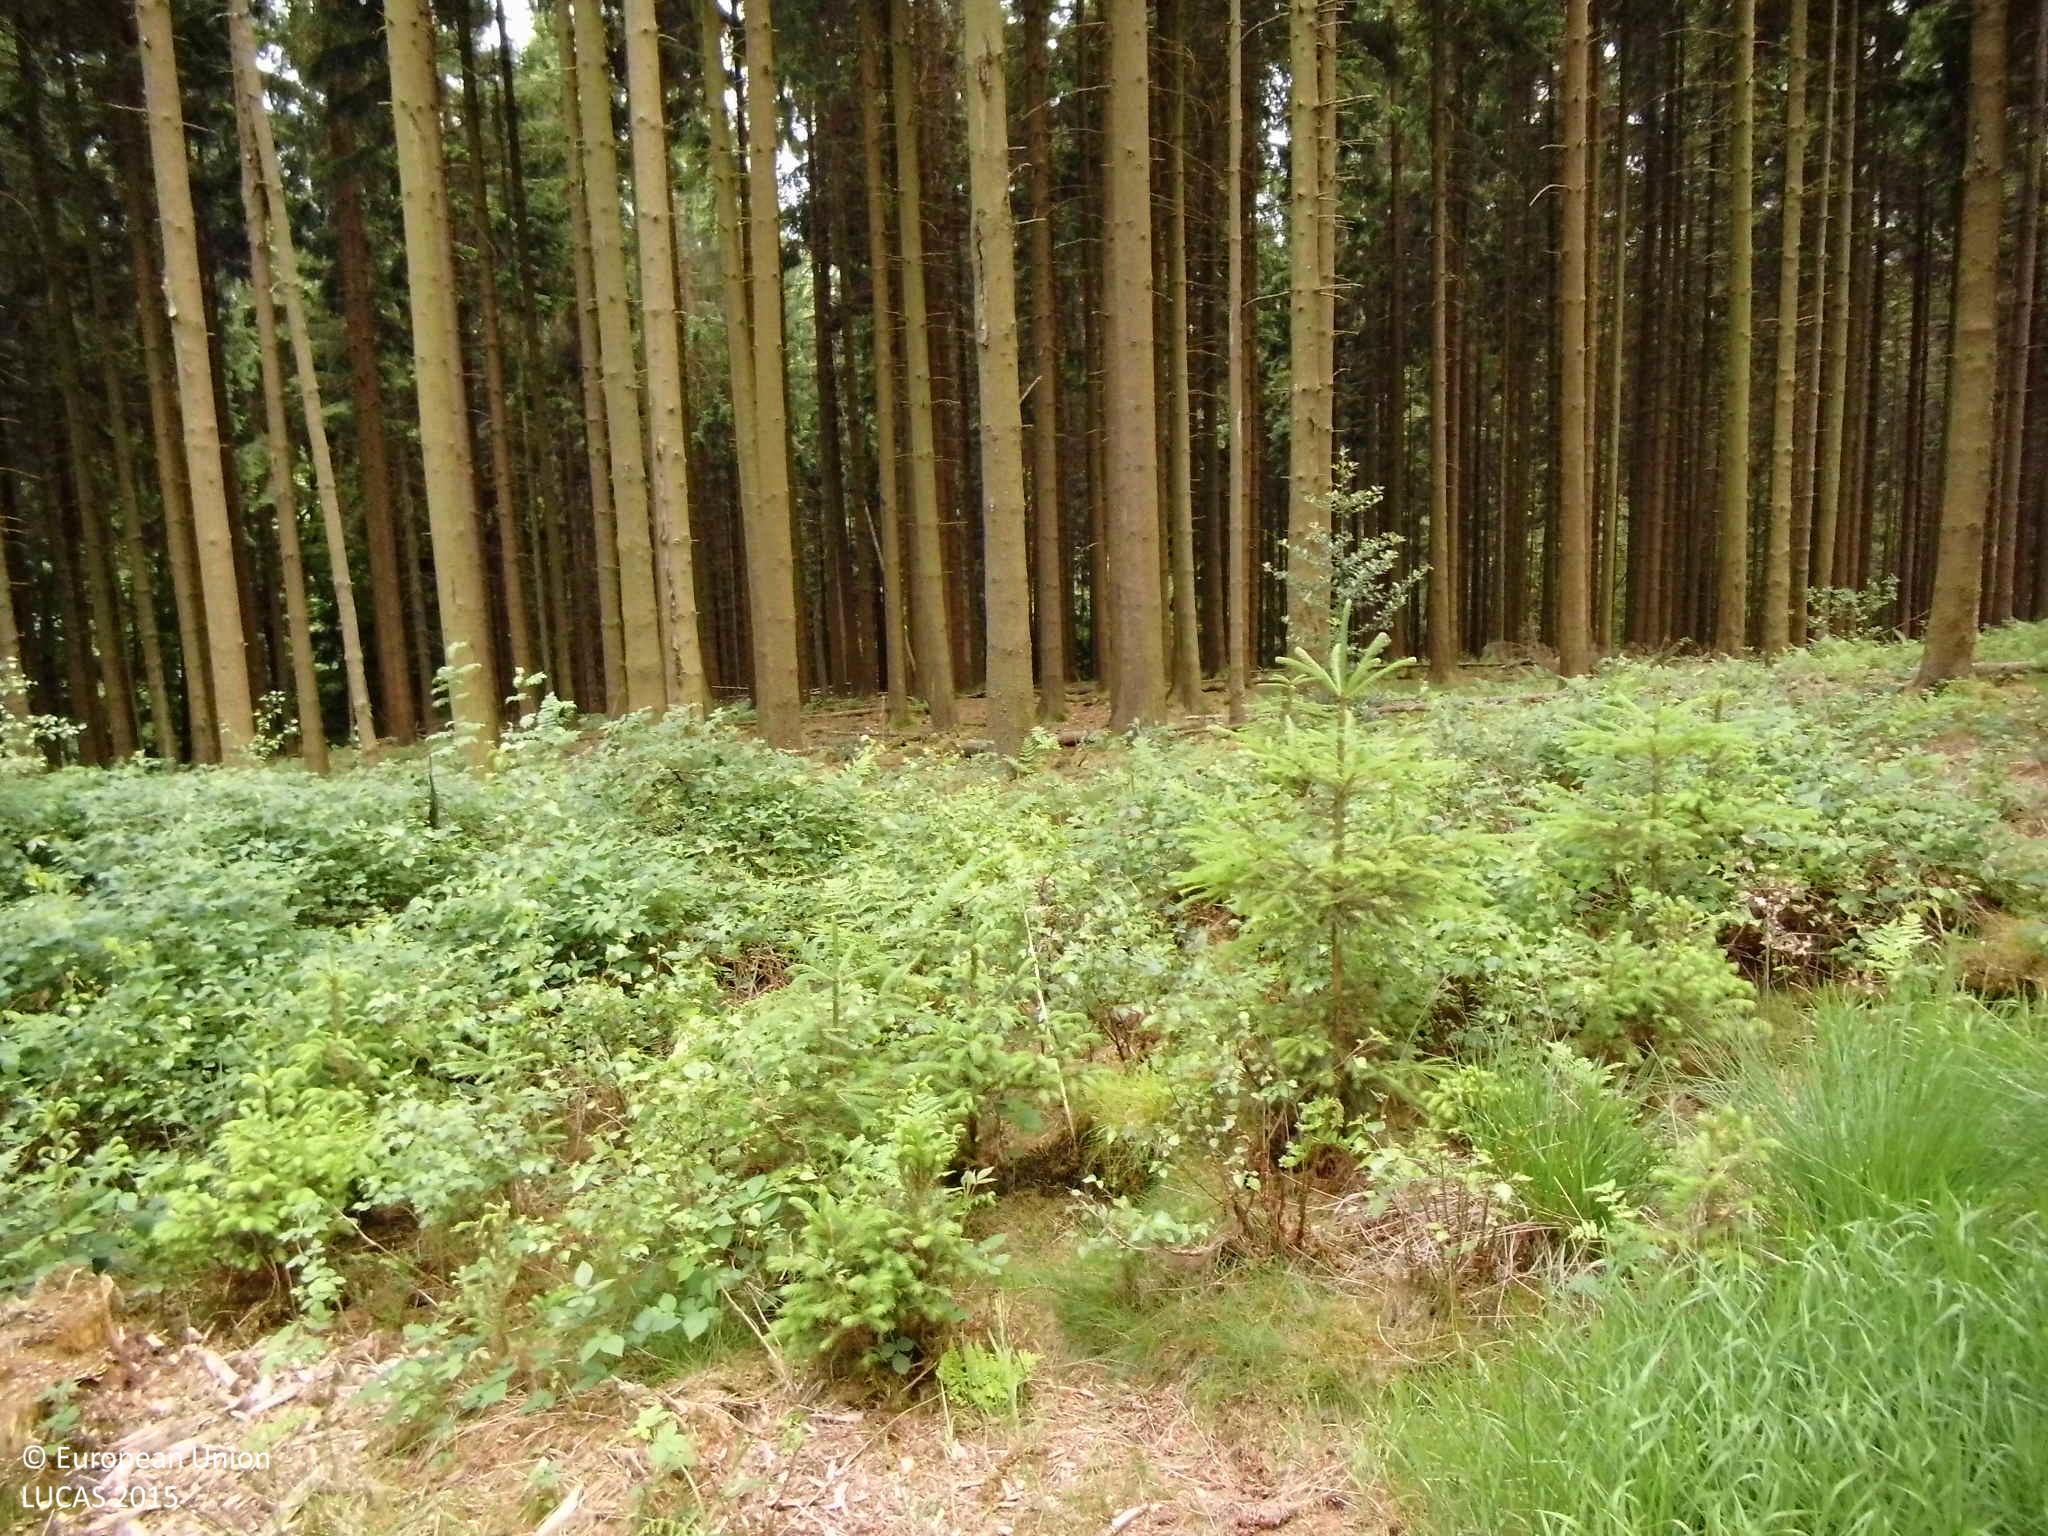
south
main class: Woodland
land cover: Spruce dominated coniferous woodland
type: hemiboreal forest and nemoral coniferous forest and mixed broadleaved-coniferous forest
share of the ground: 25 - 50 %
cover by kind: coniferous forest trees 45 %, lichens and mosses 20 %, shrubs 15 %, herbaceous plants 15 %, unconsolidated bare surface 5 %
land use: Forestry
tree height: > 5 m
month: June
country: DE
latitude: 51.2180
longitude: 7.4947
